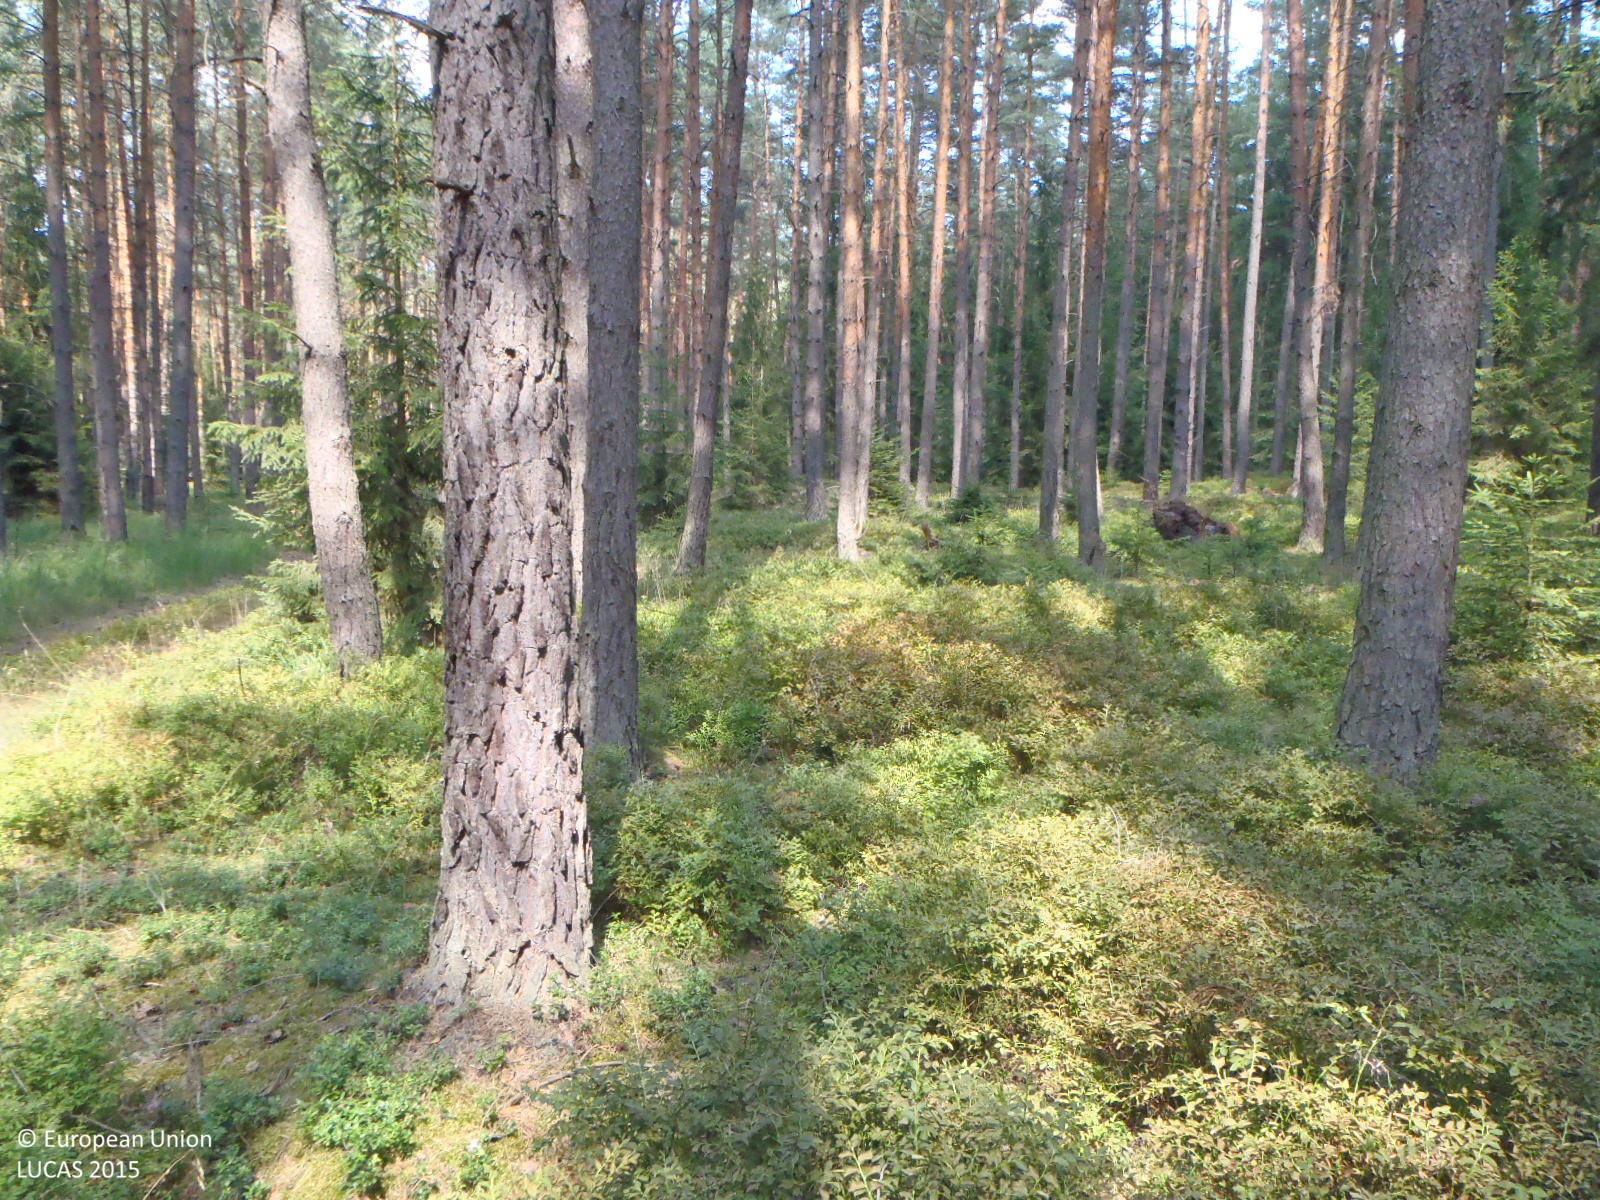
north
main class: Woodland
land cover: Pine dominated coniferous woodland
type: hemiboreal forest and nemoral coniferous forest and mixed broadleaved-coniferous forest
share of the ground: > 75 %
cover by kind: coniferous forest trees 95 %, shrubs 5 %
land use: Forestry
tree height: > 5 m
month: August
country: CZ
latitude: 50.5903
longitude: 14.7343
